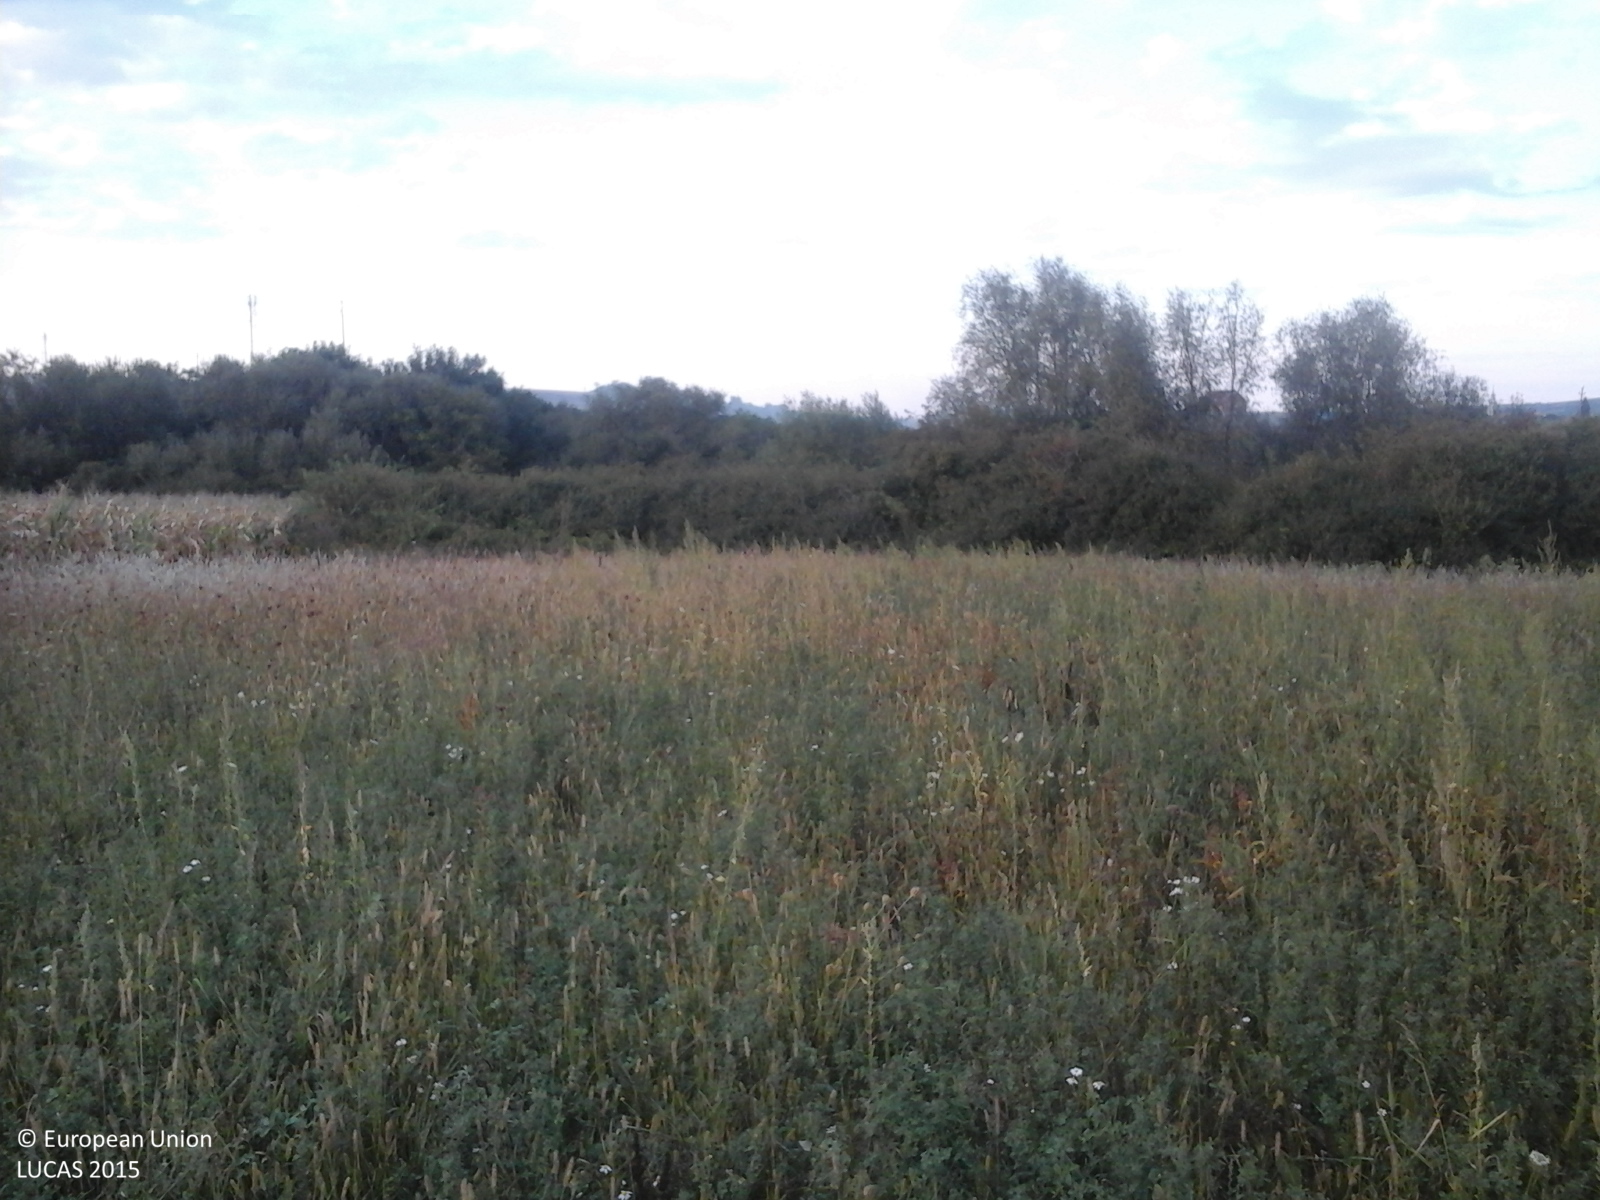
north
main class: Cropland
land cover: Lucerne
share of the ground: > 75 %
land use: Agriculture (excluding fallow land and kitchen gardens)
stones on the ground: < 10 %
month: September
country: RO
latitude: 47.4576
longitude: 22.7819
